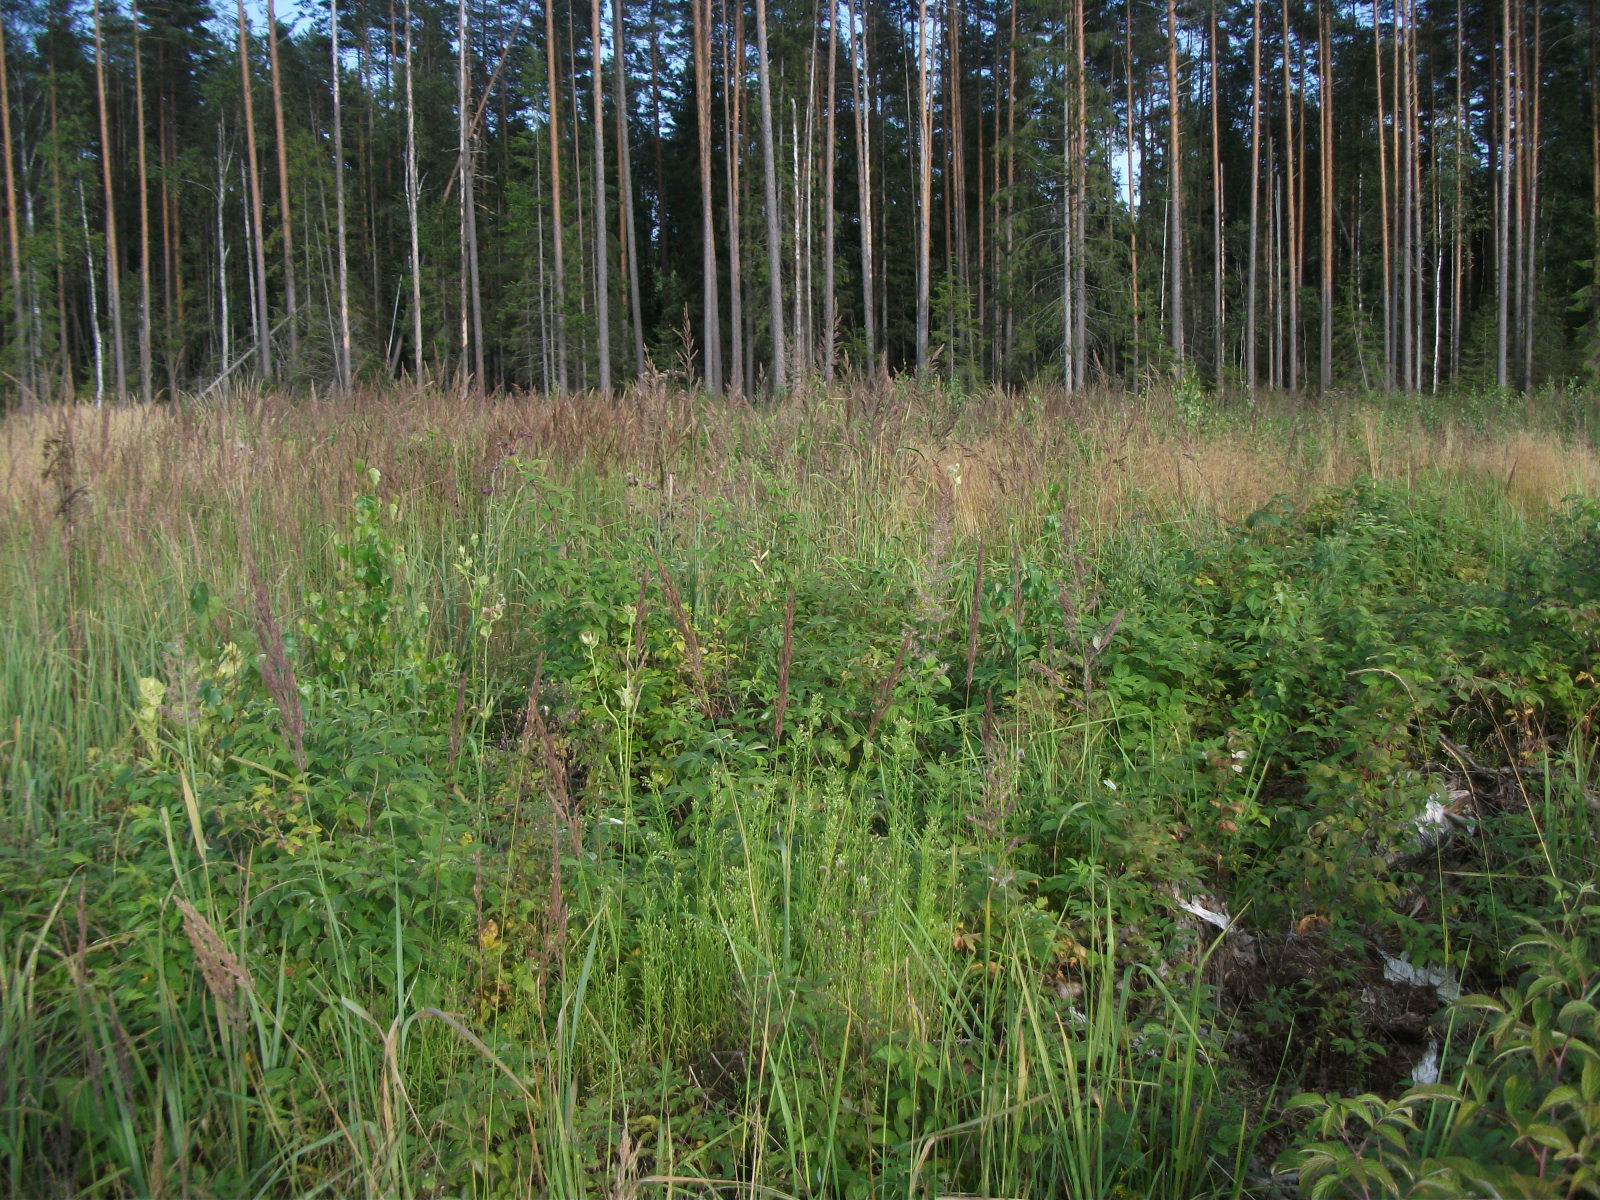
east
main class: Shrubland
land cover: Shrubland with sparse tree cover
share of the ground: > 75 %
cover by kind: shrubs 70 %, herbaceous plants 20 %, broadleaved forest trees 5 %, unconsolidated bare surface 5 %
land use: Forestry
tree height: < 5 m
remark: Clear cut
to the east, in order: Shrubland with sparse tree cover; Other coniferous woodland; Pine dominated coniferous woodland; Other mixed woodland; Pine dominated coniferous woodland; Ditches and canals; Other coniferous woodland
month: August
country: LV
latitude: 56.8748
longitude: 26.5045
